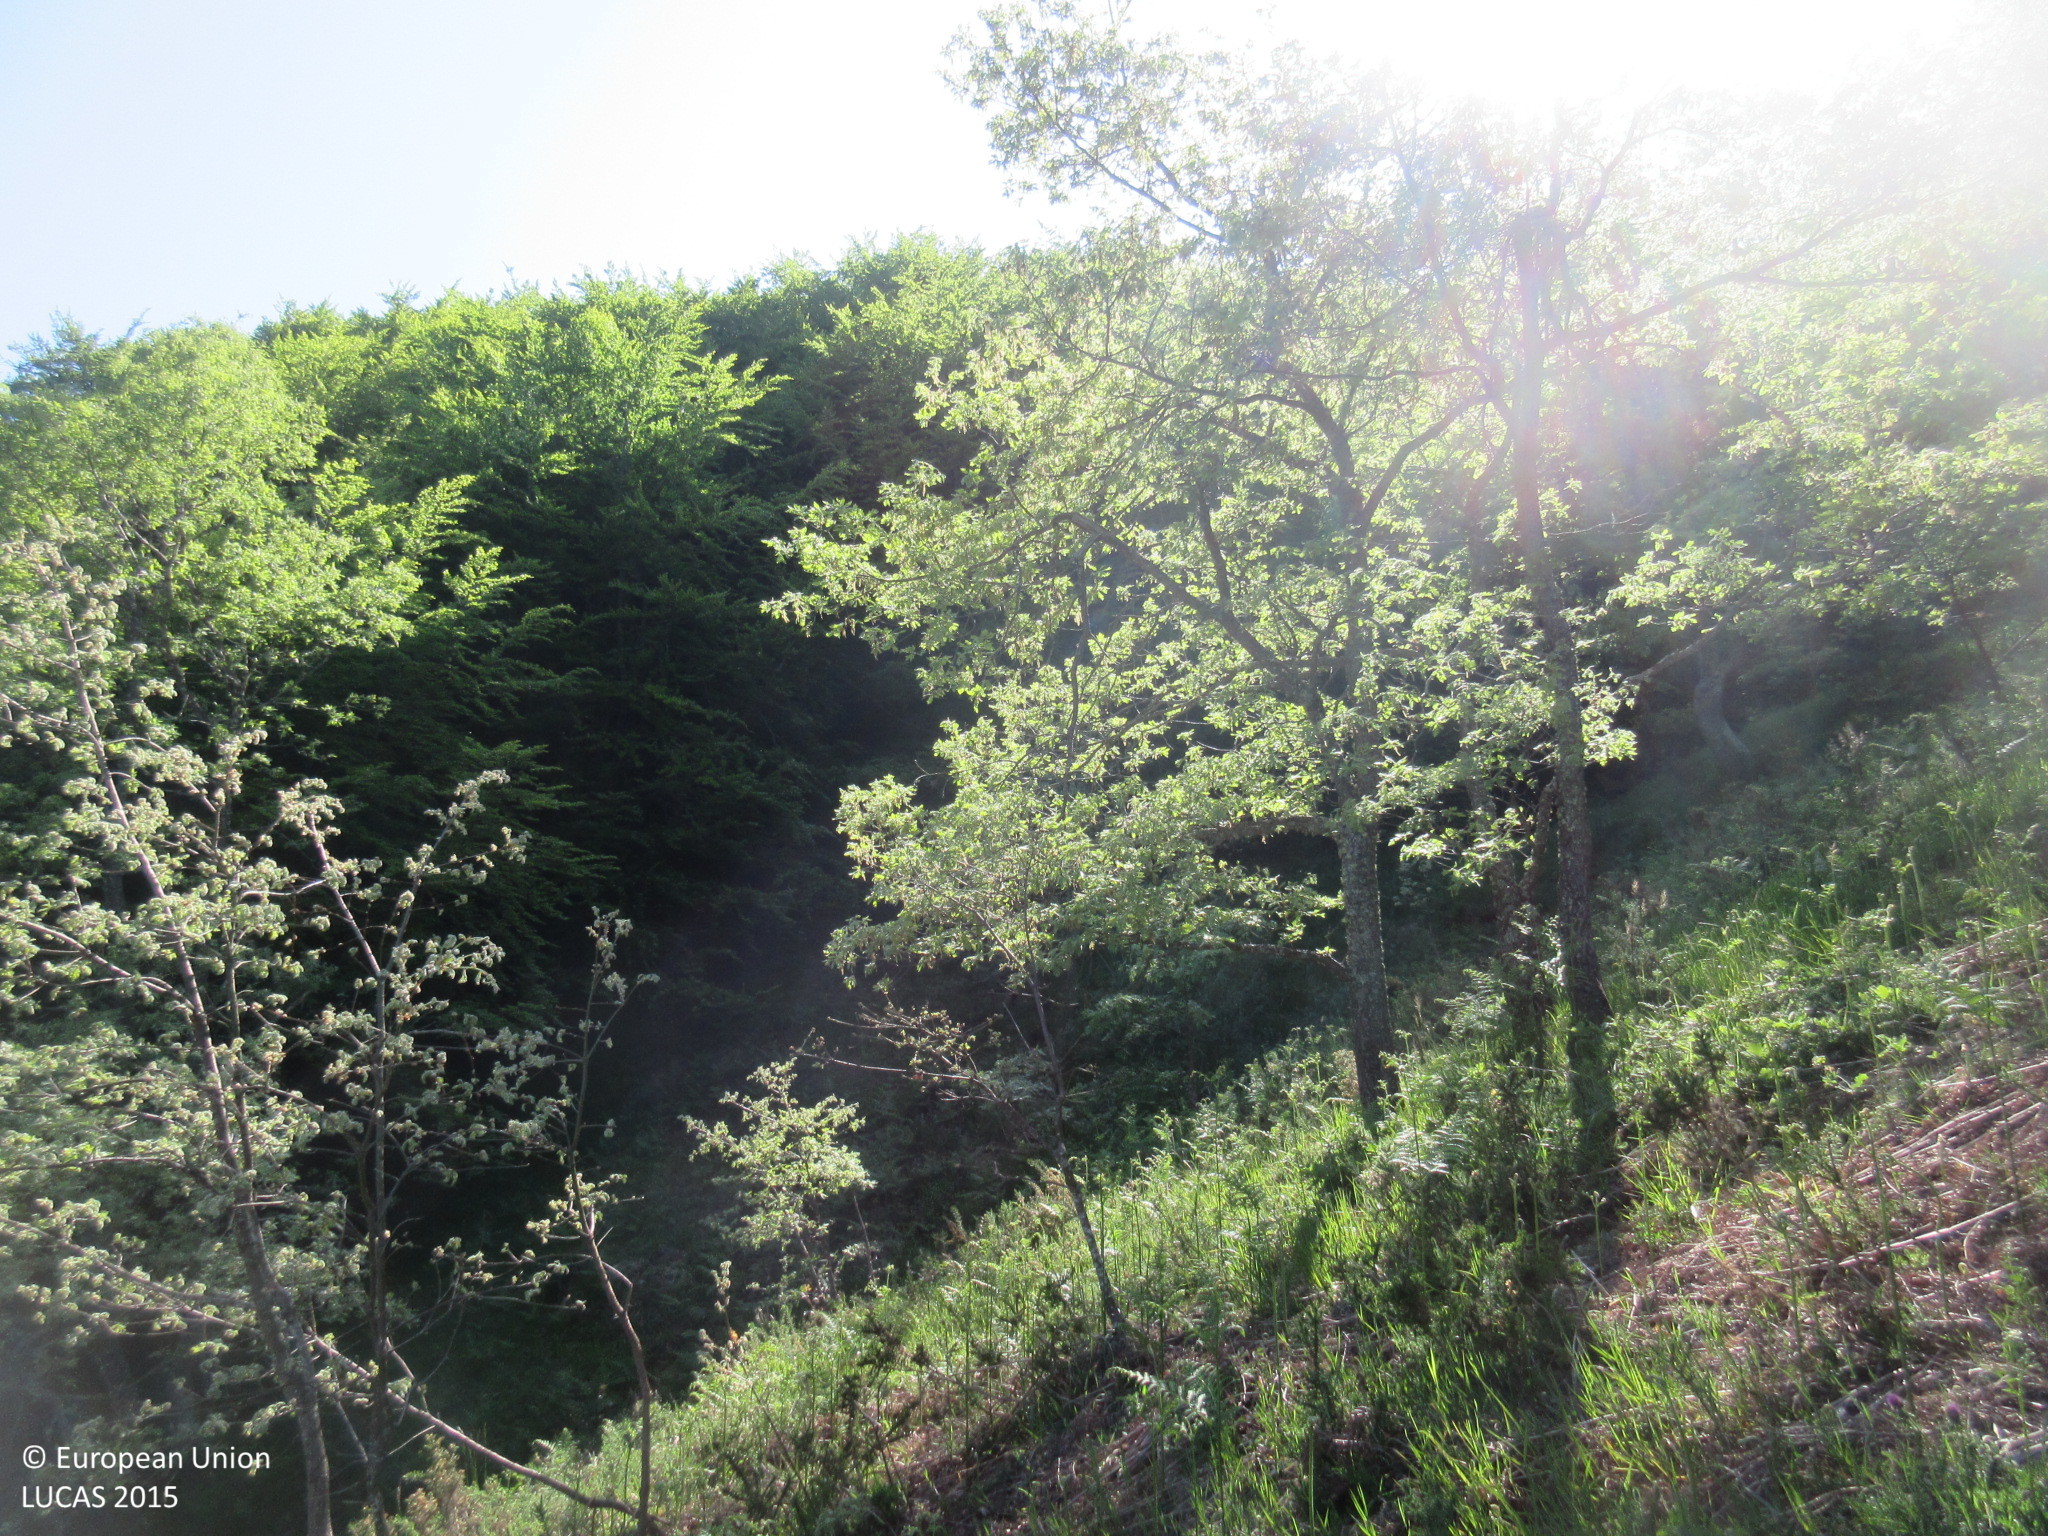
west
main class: Woodland
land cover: Broadleaved woodland
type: acidophilous oak and oak-birch forest
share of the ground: 50 - 75 %
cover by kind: broadleaved forest trees 60 %, shrubs 30 %, herbaceous plants 10 %
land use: Agriculture (excluding fallow land and kitchen gardens)
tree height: > 5 m
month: June
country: ES
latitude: 43.0994
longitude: -4.4190
